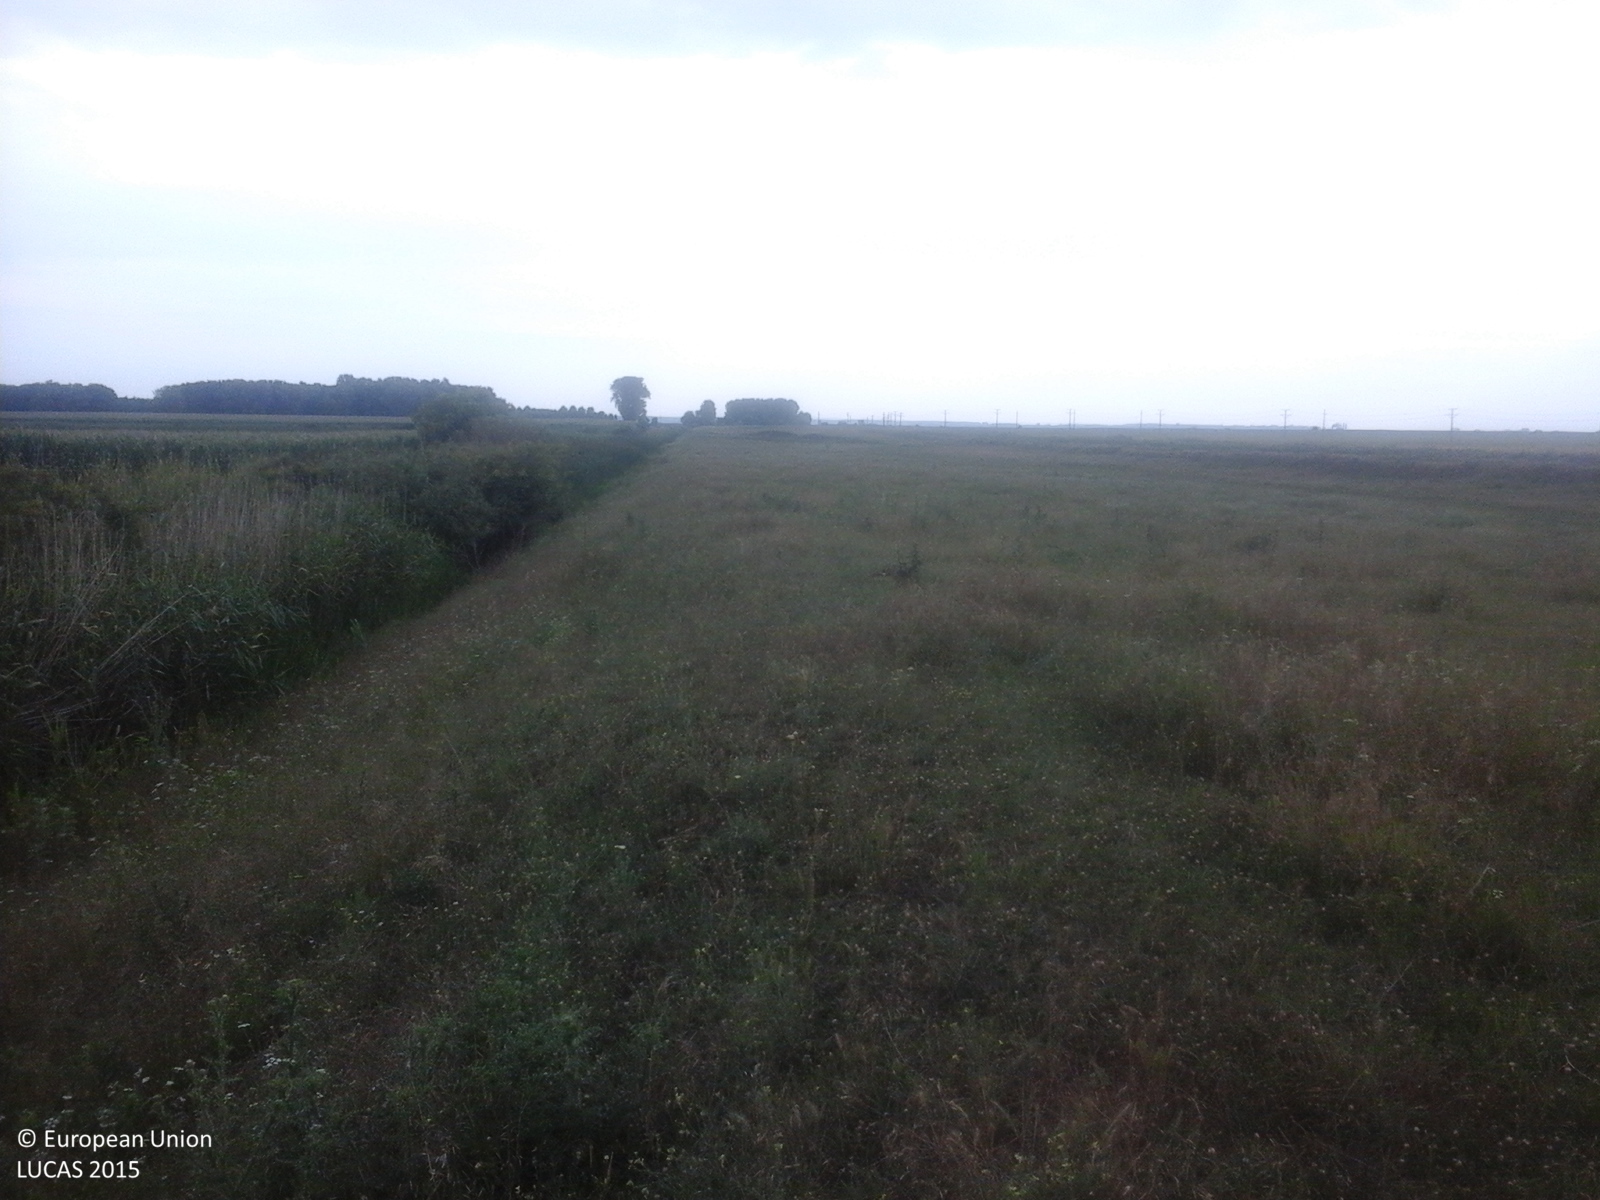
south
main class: Grassland
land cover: Grassland without tree/shrub cover
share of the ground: > 75 %
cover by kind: herbaceous plants 100 %
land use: Agriculture (excluding fallow land and kitchen gardens)
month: June
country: RO
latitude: 44.0639
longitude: 26.1702
